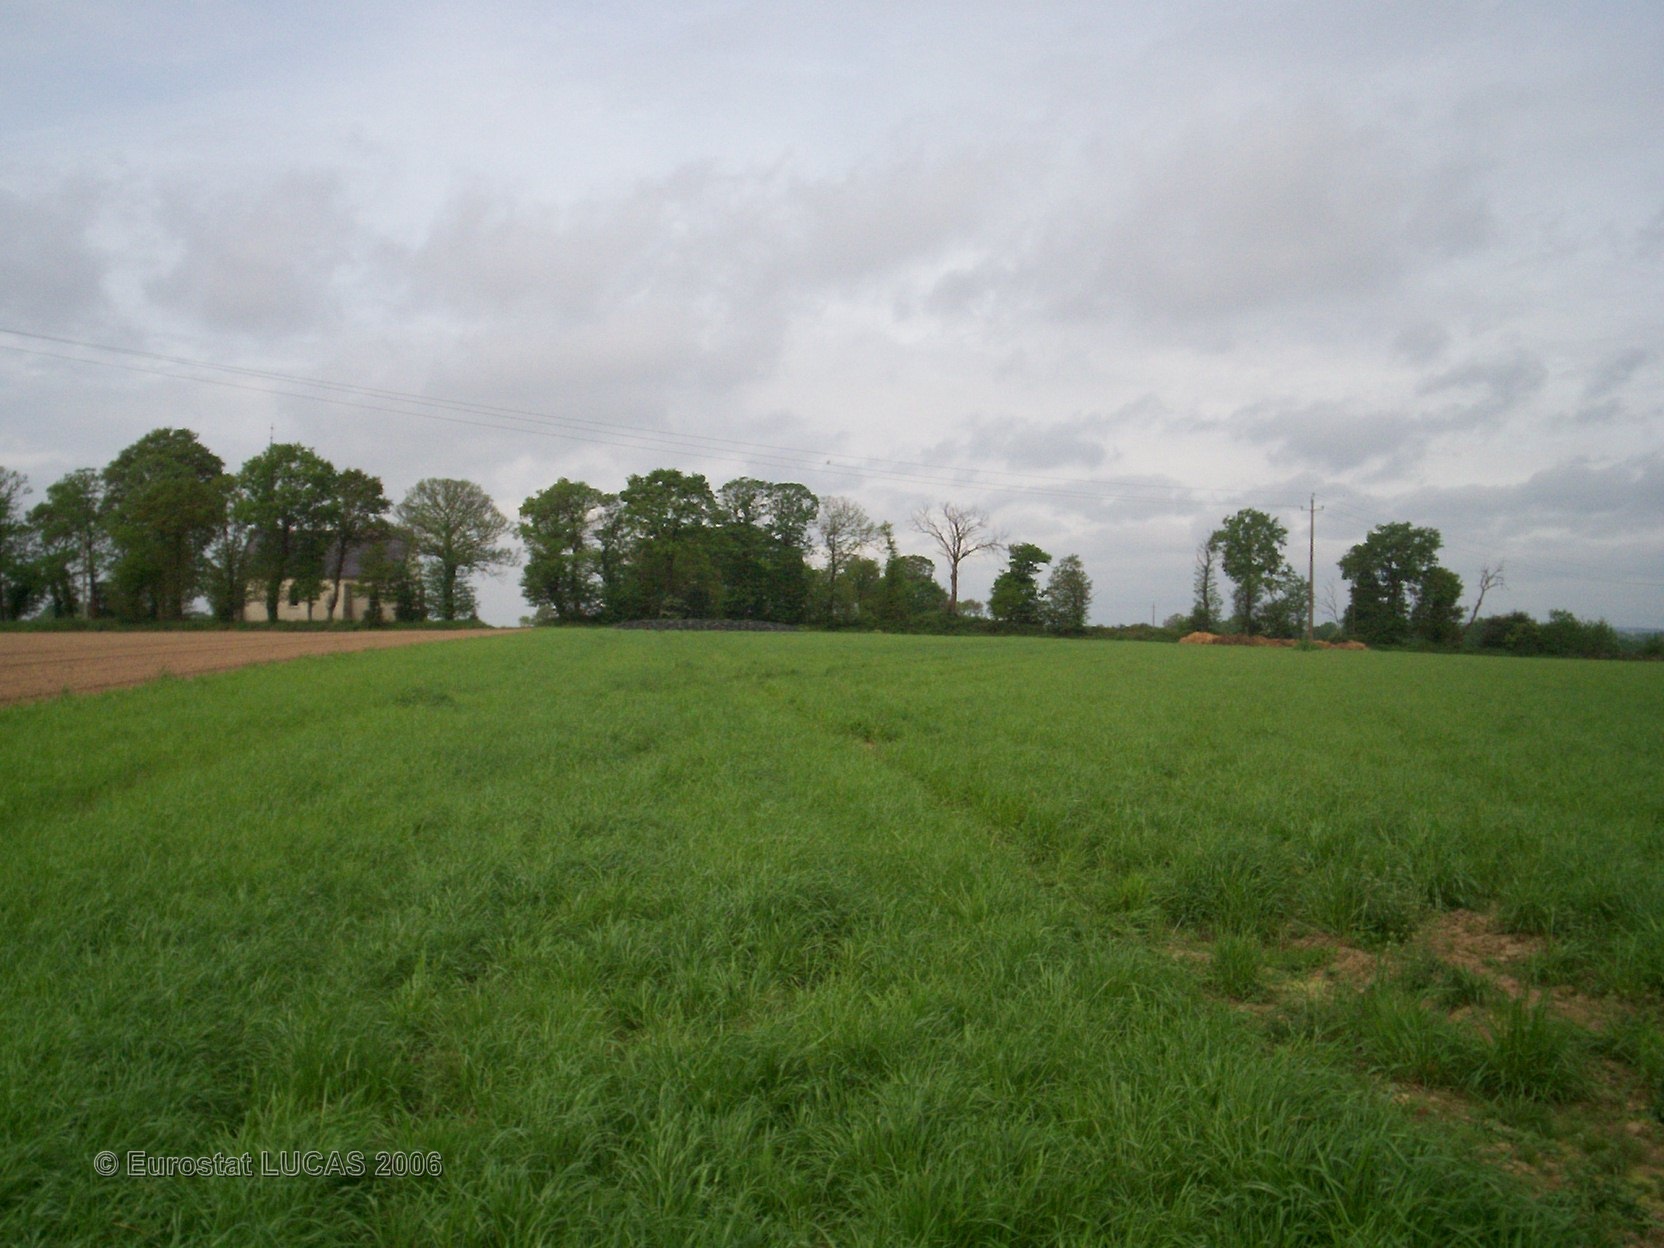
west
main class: Grassland
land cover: Grassland without tree/shrub cover
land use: Agriculture (excluding fallow land and kitchen gardens)
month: May
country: FR
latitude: 47.8519
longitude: -2.3654
